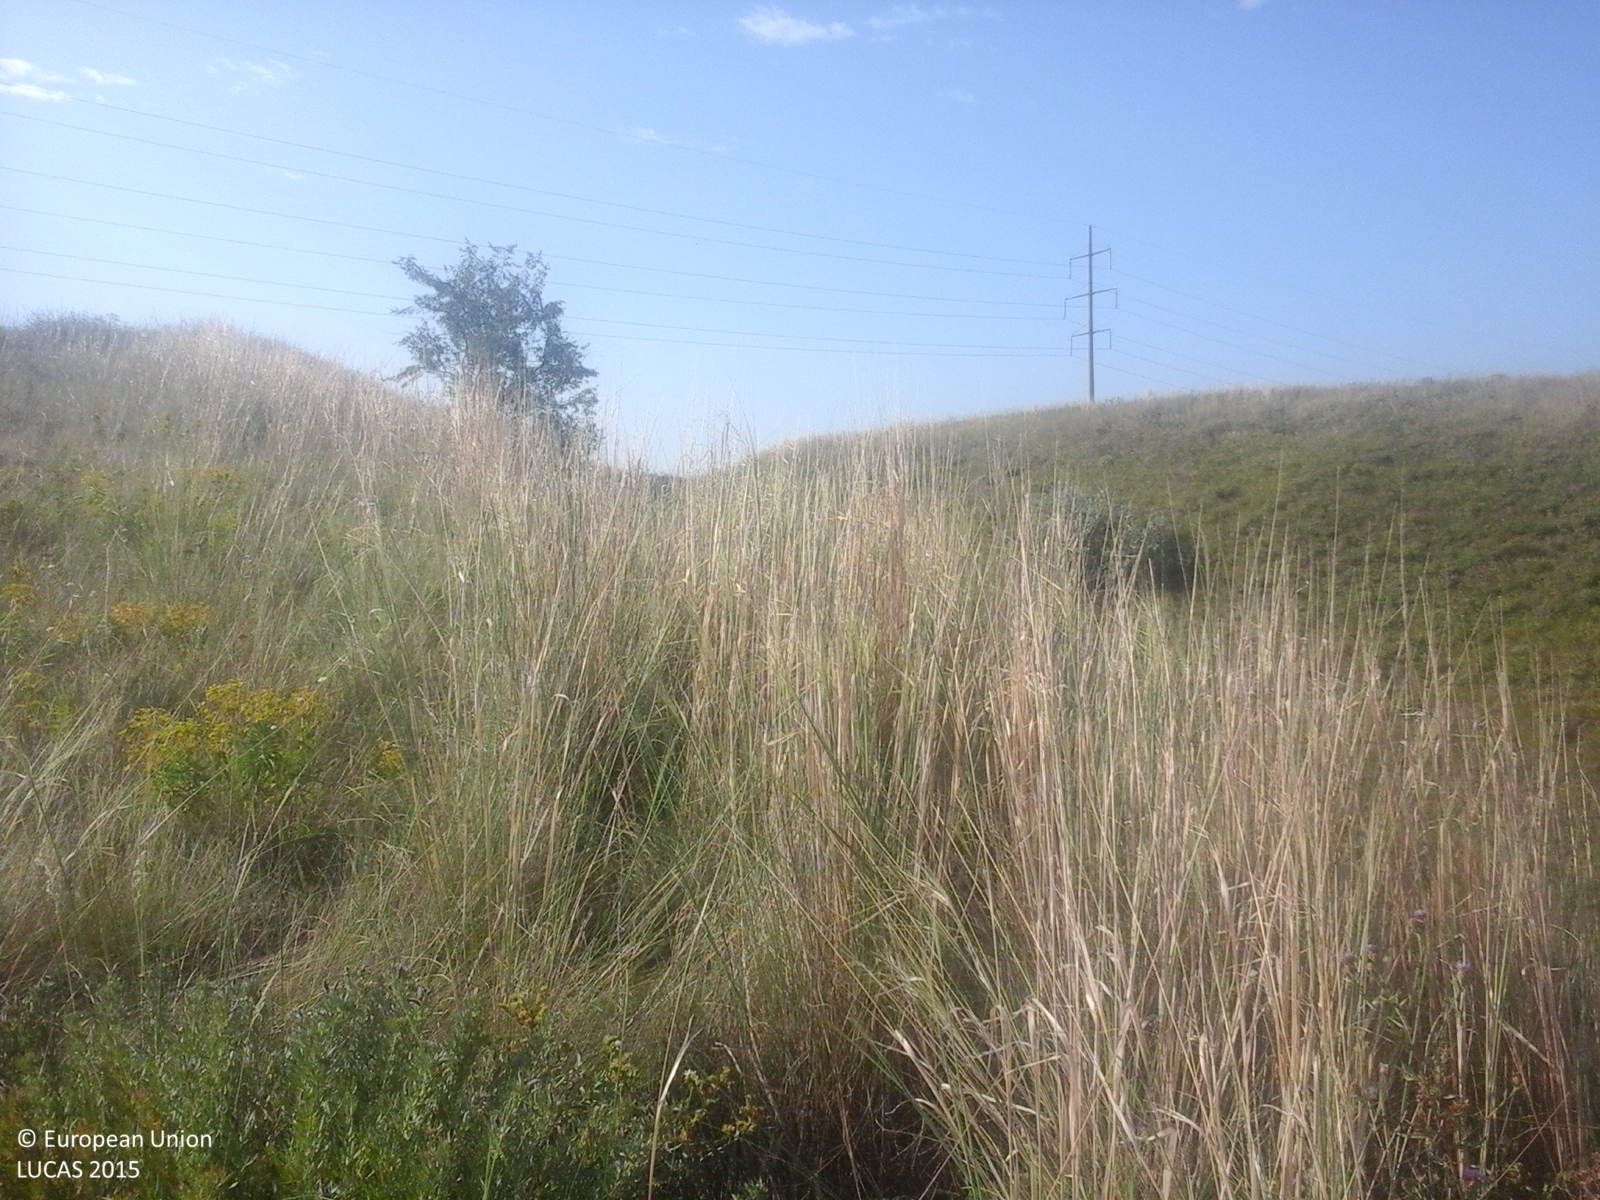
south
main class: Grassland
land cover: Grassland without tree/shrub cover
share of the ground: > 75 %
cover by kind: herbaceous plants 100 %
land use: Agriculture (excluding fallow land and kitchen gardens)
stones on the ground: < 10 %
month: July
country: RO
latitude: 46.6139
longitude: 27.8953
